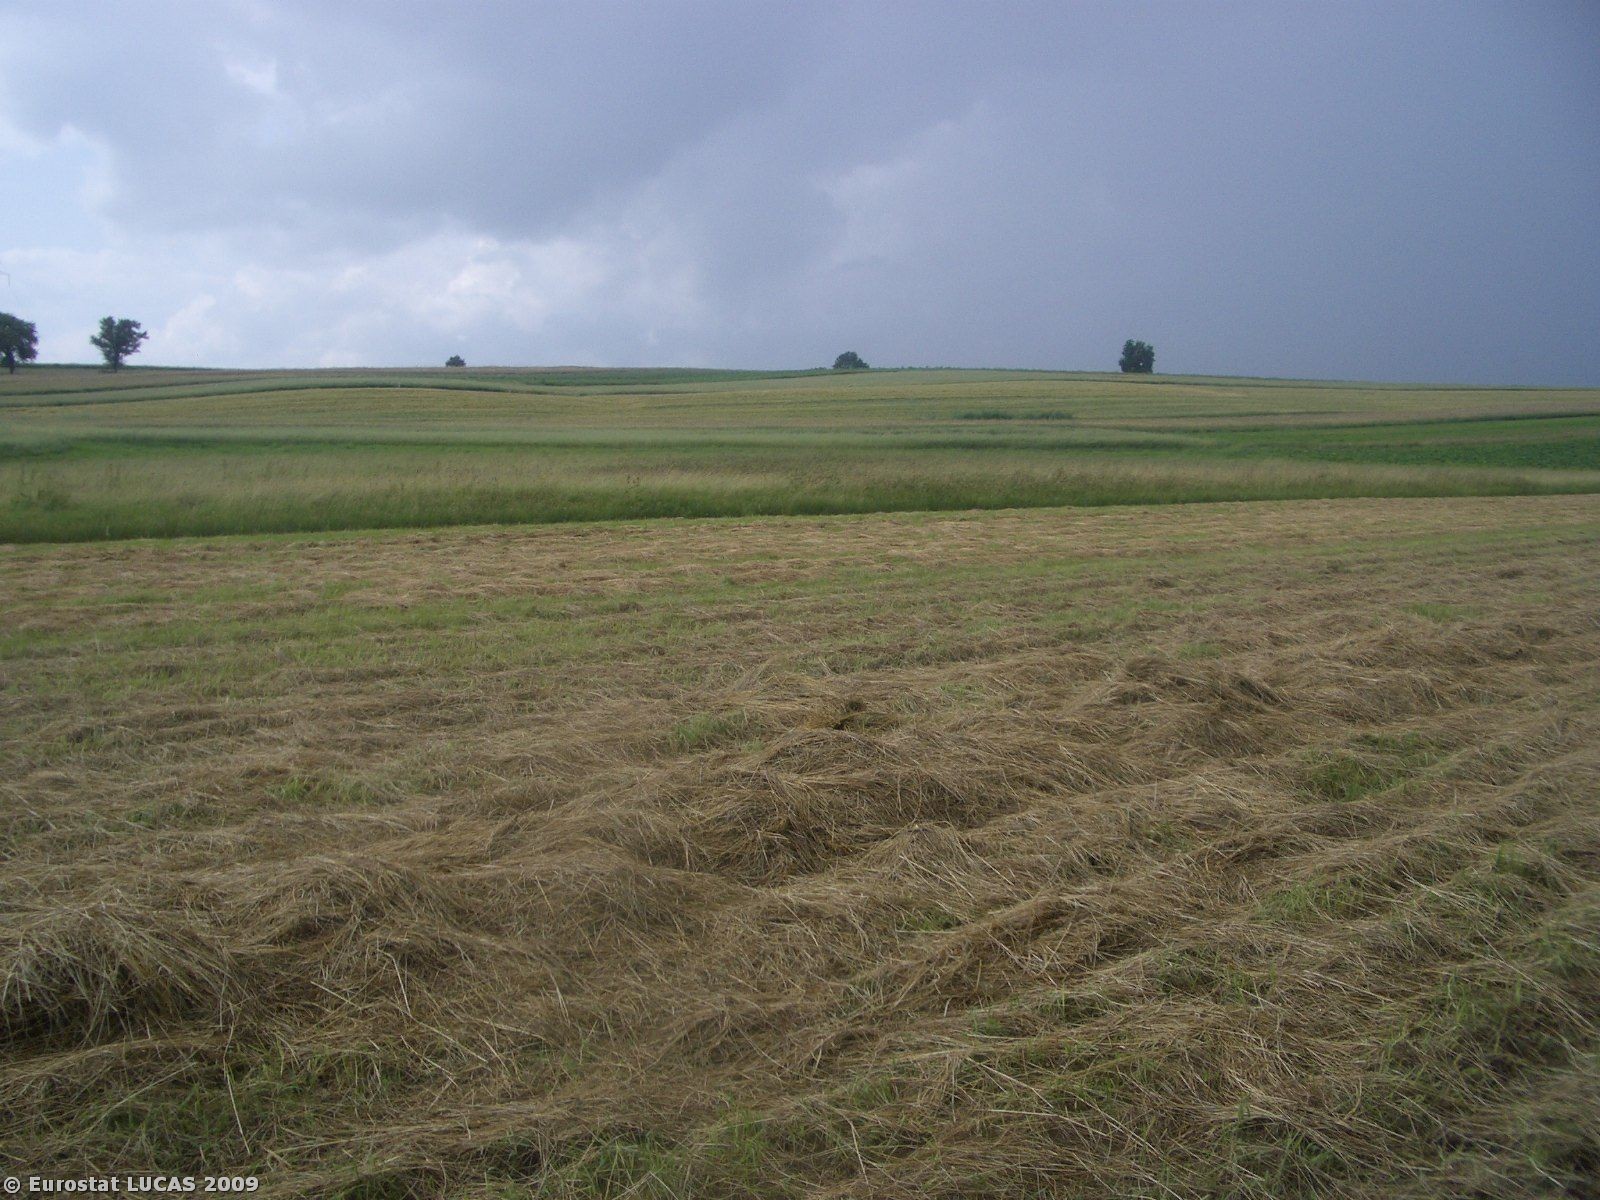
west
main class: Woodland
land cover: Broadleaved woodland
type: mesophytic deciduous forest
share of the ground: > 75 %
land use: Unused
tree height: > 5 m
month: July
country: PL
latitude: 51.3071
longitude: 22.3868
